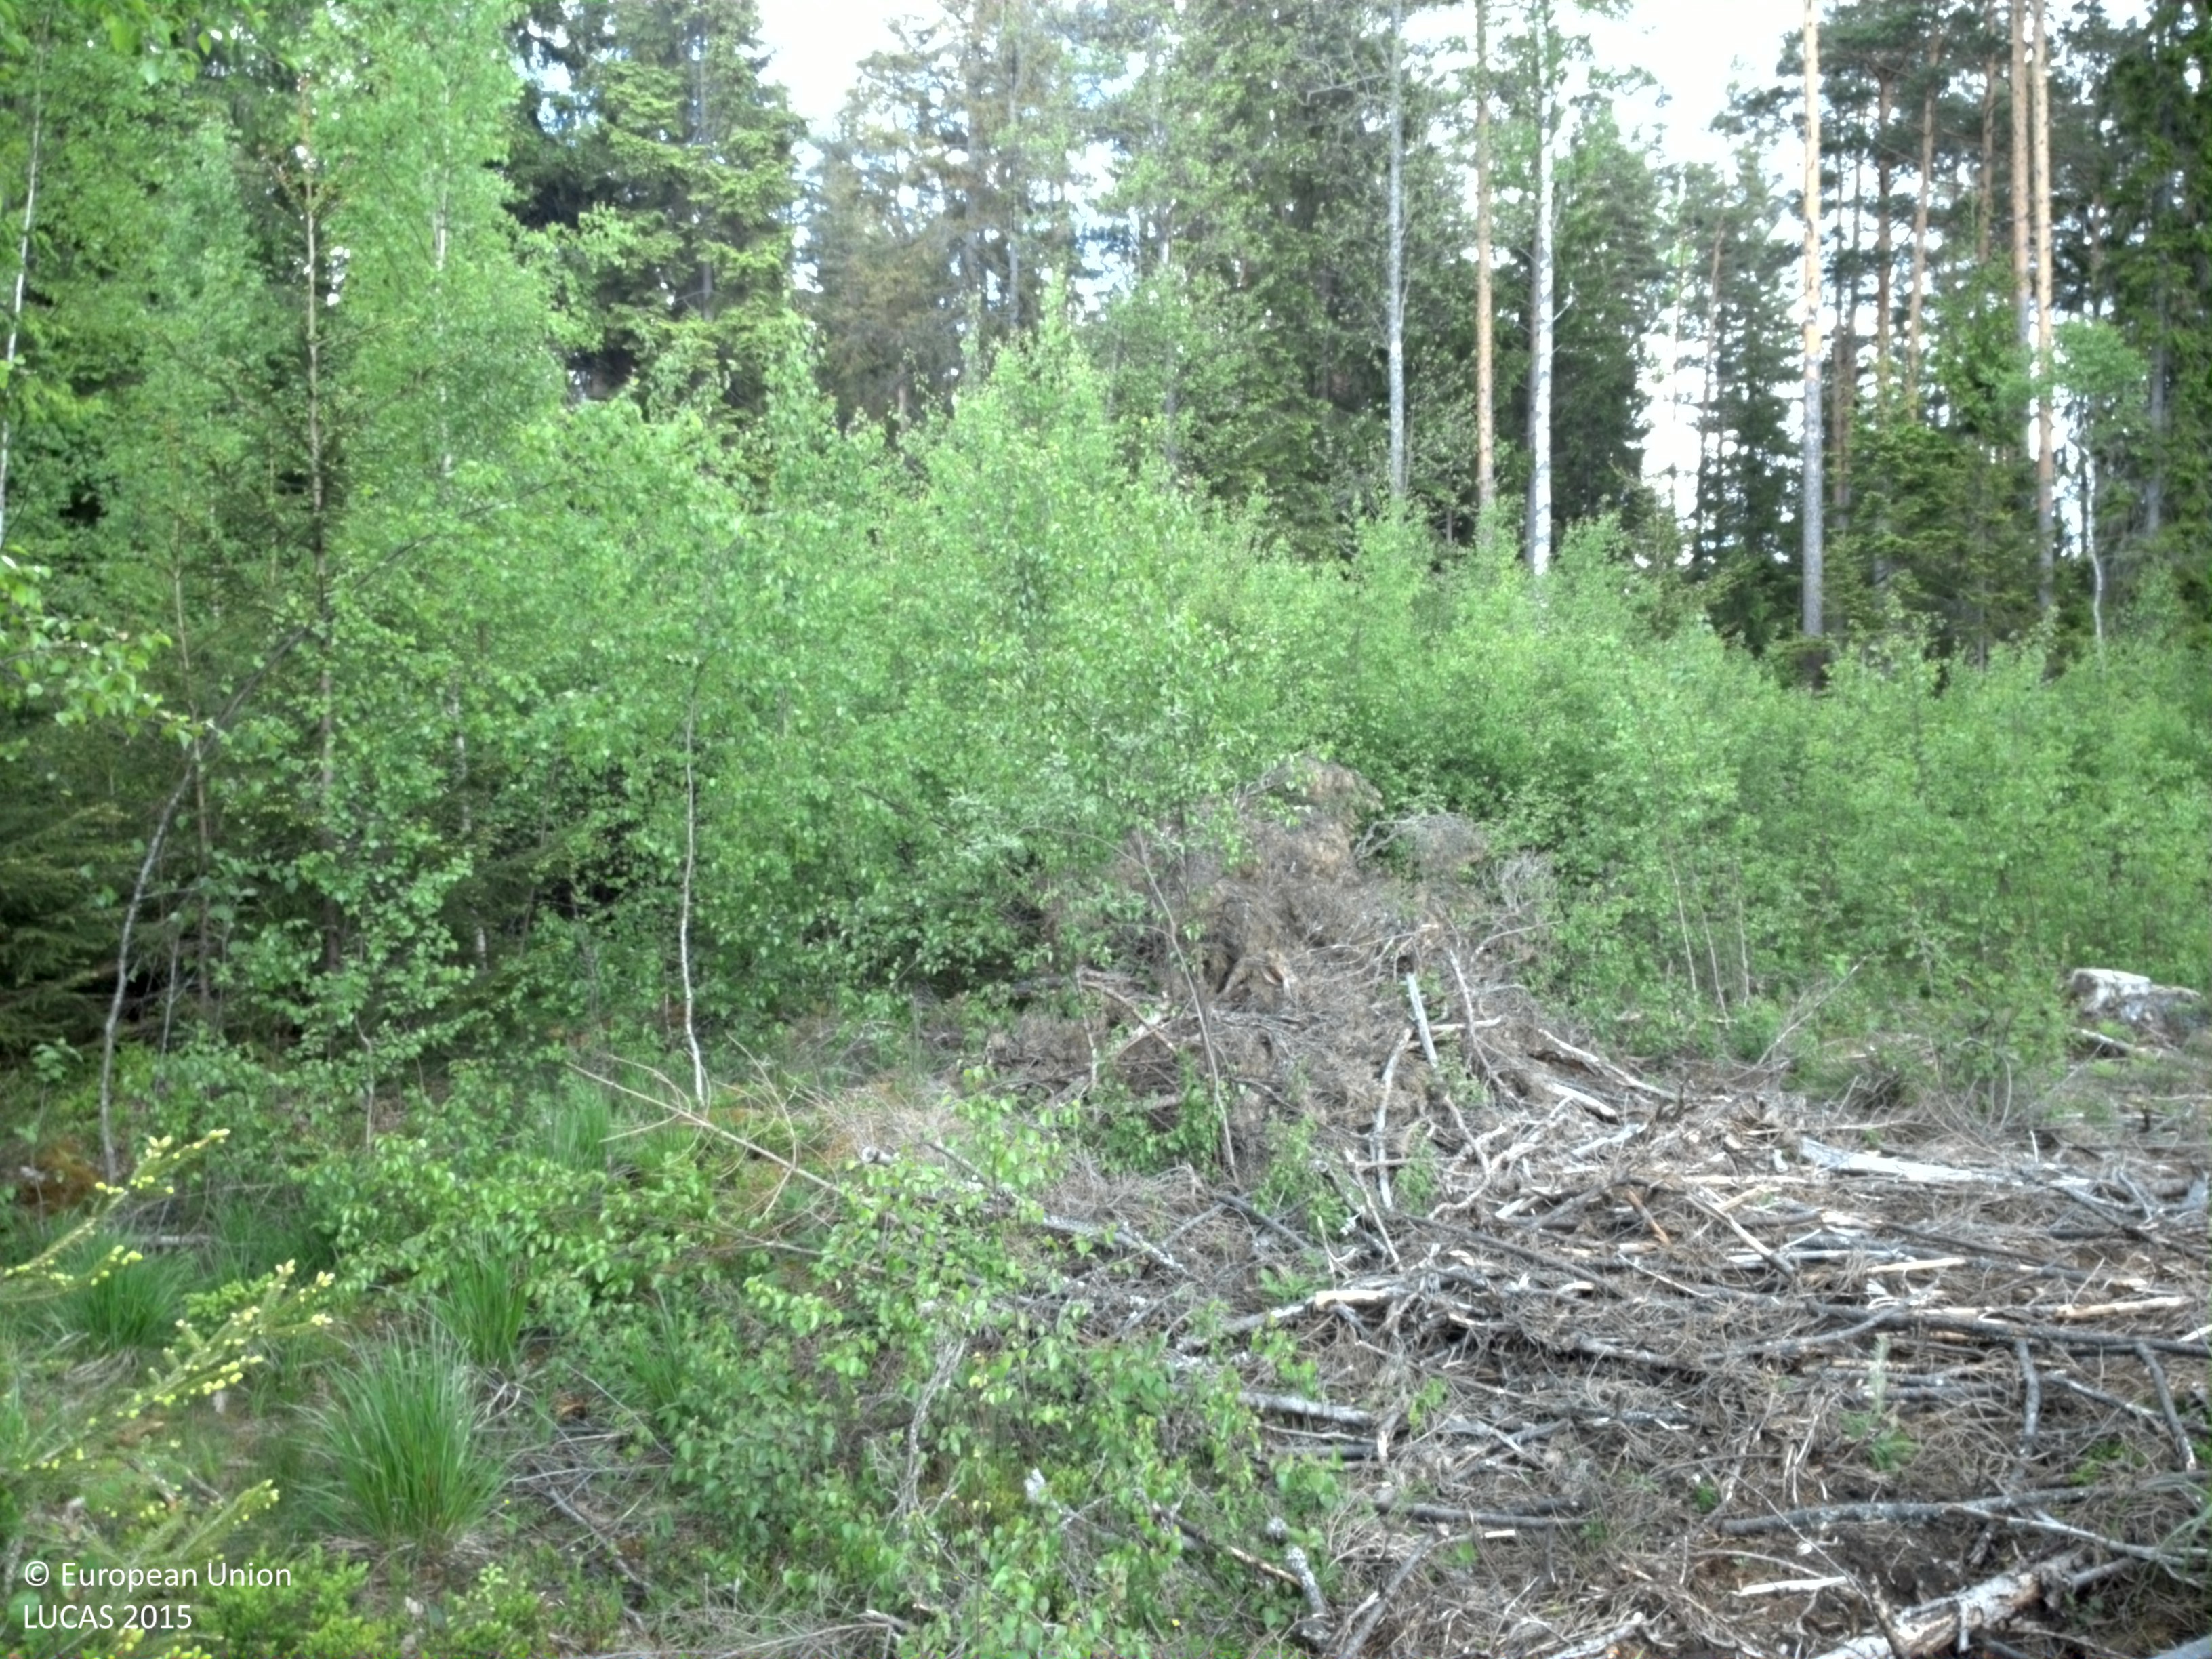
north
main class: Woodland
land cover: Spruce dominated coniferous woodland
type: boreal forest
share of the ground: 10 - 25 %
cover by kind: lichens and mosses 35 %, shrubs 25 %, coniferous forest trees 20 %, herbaceous plants 10 %, broadleaved forest trees 5 %, unconsolidated bare surface 5 %
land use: Forestry
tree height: > 5 m
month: May
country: SE
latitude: 57.2818
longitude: 15.8205
